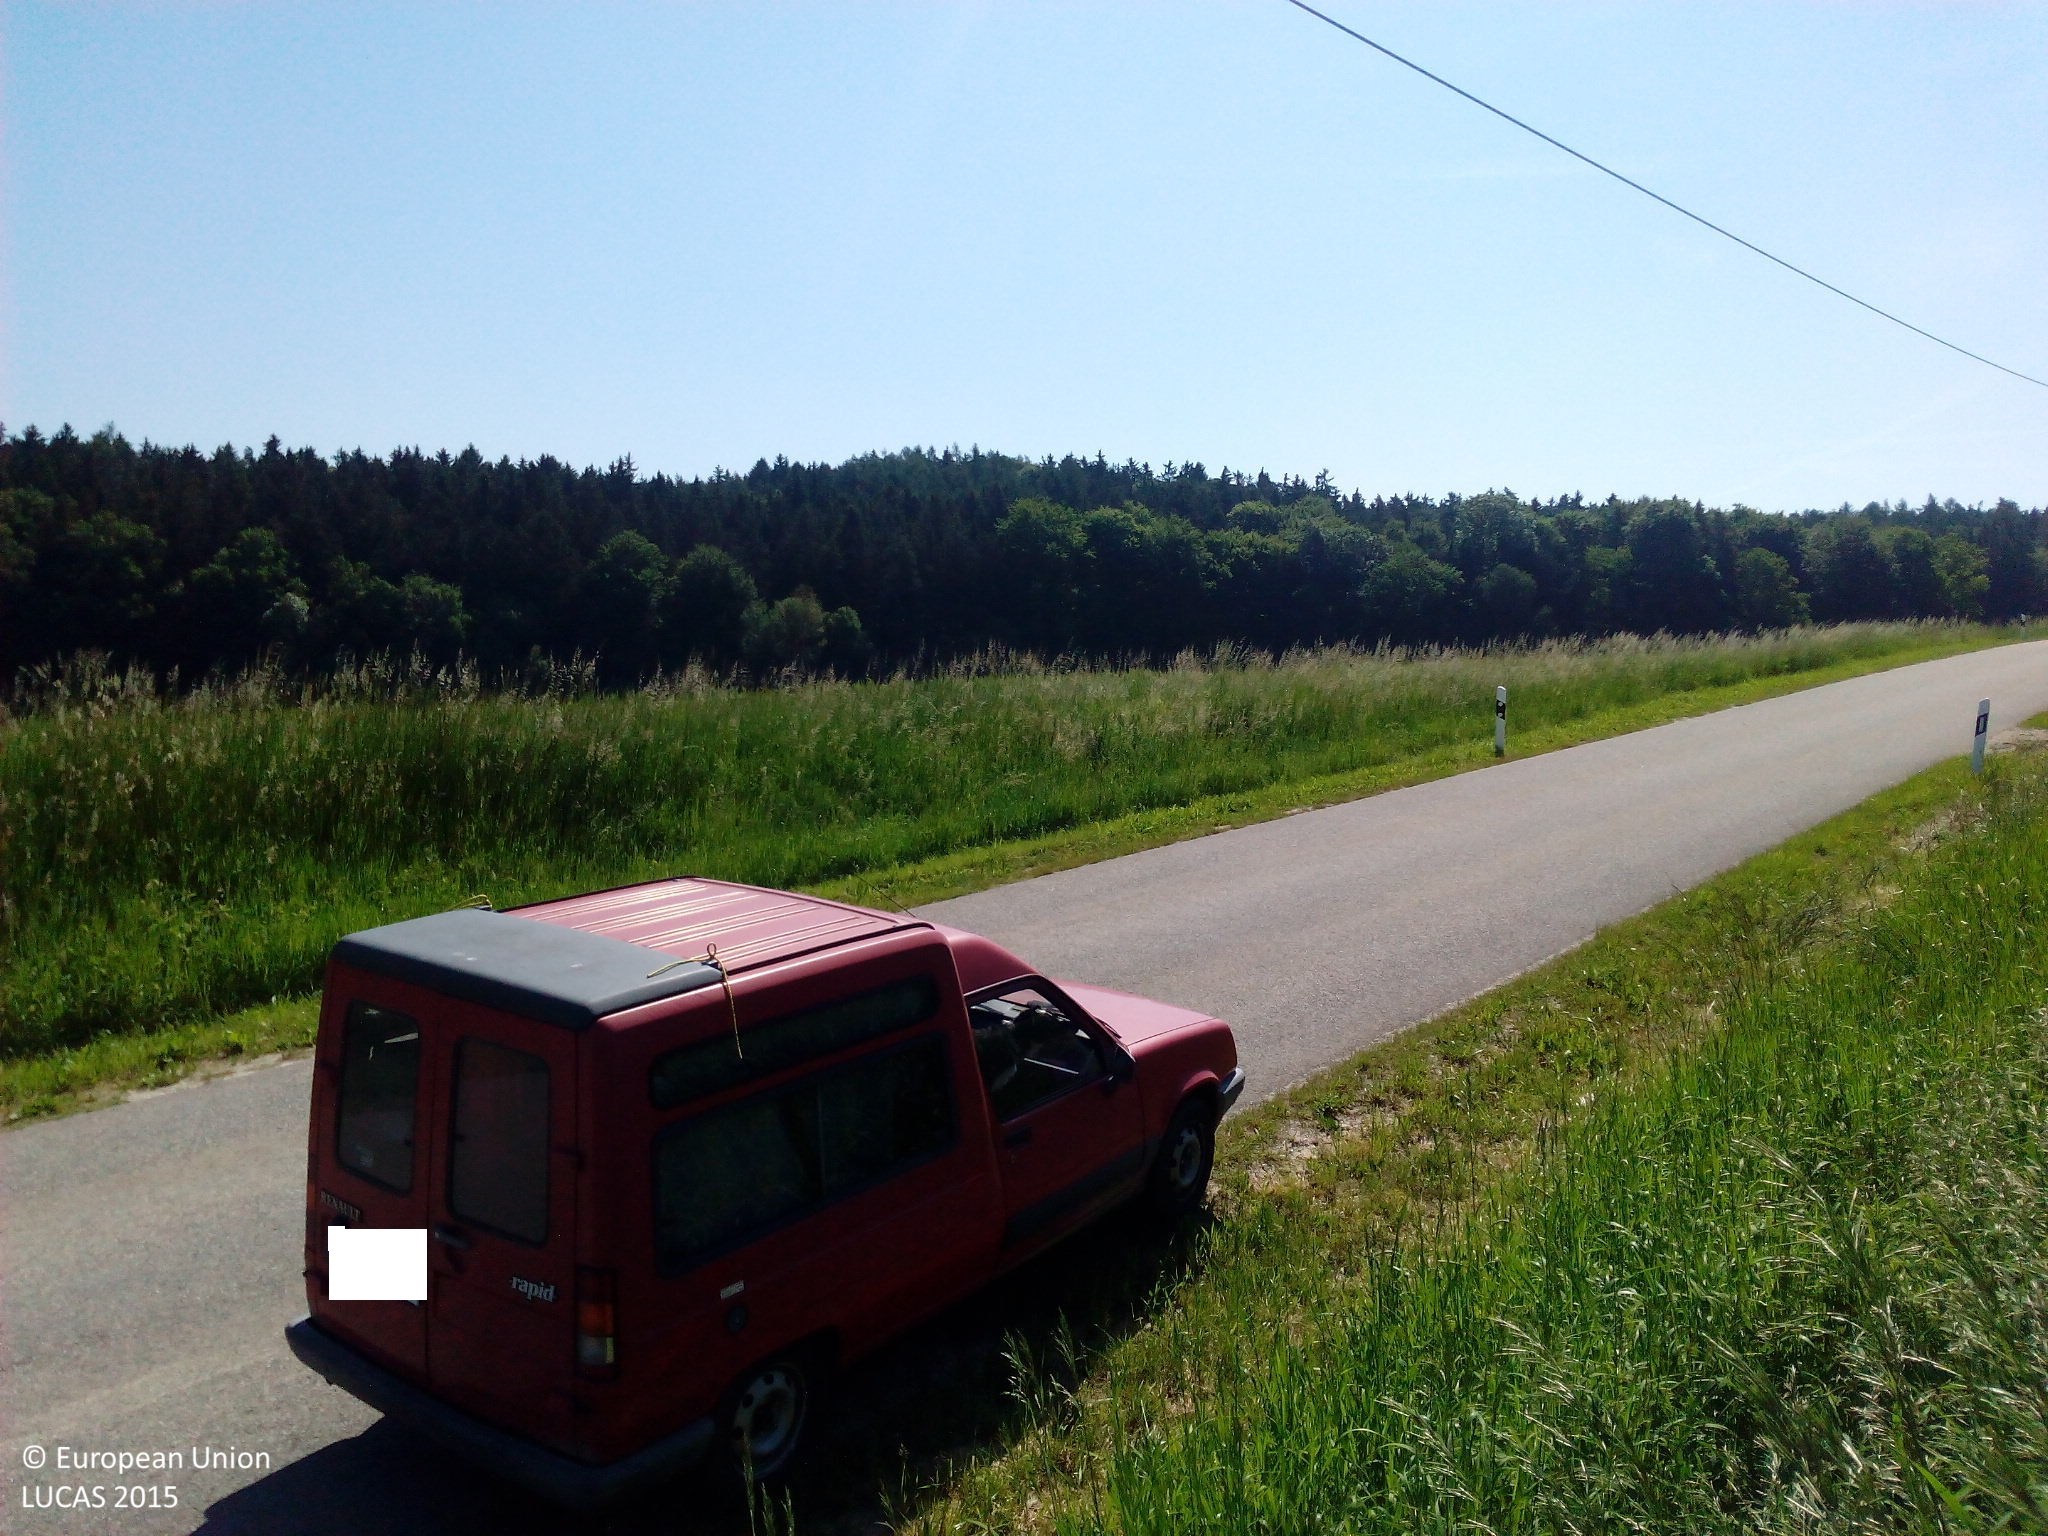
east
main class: Grassland
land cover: Grassland without tree/shrub cover
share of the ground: > 75 %
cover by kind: herbaceous plants 100 %
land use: Agriculture (excluding fallow land and kitchen gardens)
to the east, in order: Grassland without tree/shrub cover; Electric lines; Grass margins; Paved roads, cycling and walking lanes; Grassland without tree/shrub cover; Triticale; Common wheat; Broadleaved woodland; Spruce dominated coniferous woodland
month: June
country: DE
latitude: 48.6834
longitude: 12.4034
